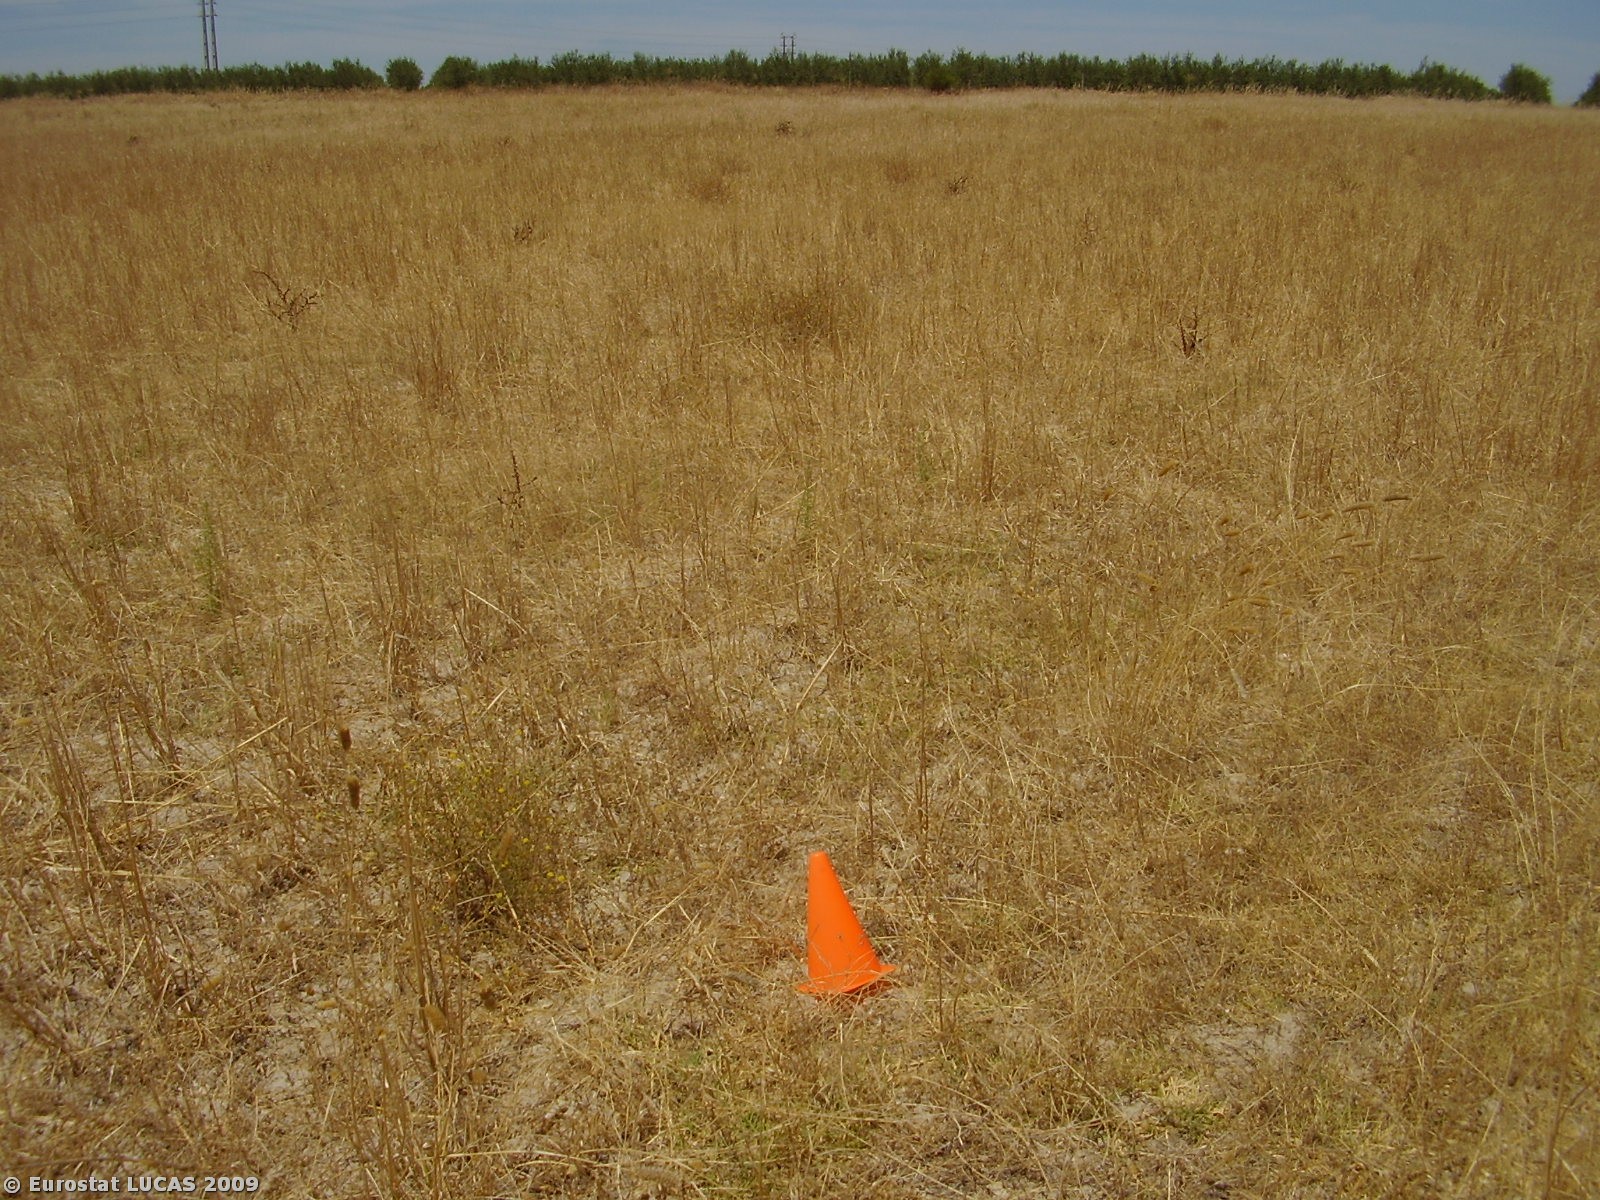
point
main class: Cropland
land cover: Oats
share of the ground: > 75 %
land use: Agriculture (excluding fallow land and kitchen gardens)
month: August
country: PT
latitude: 38.0973
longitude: -7.8520
